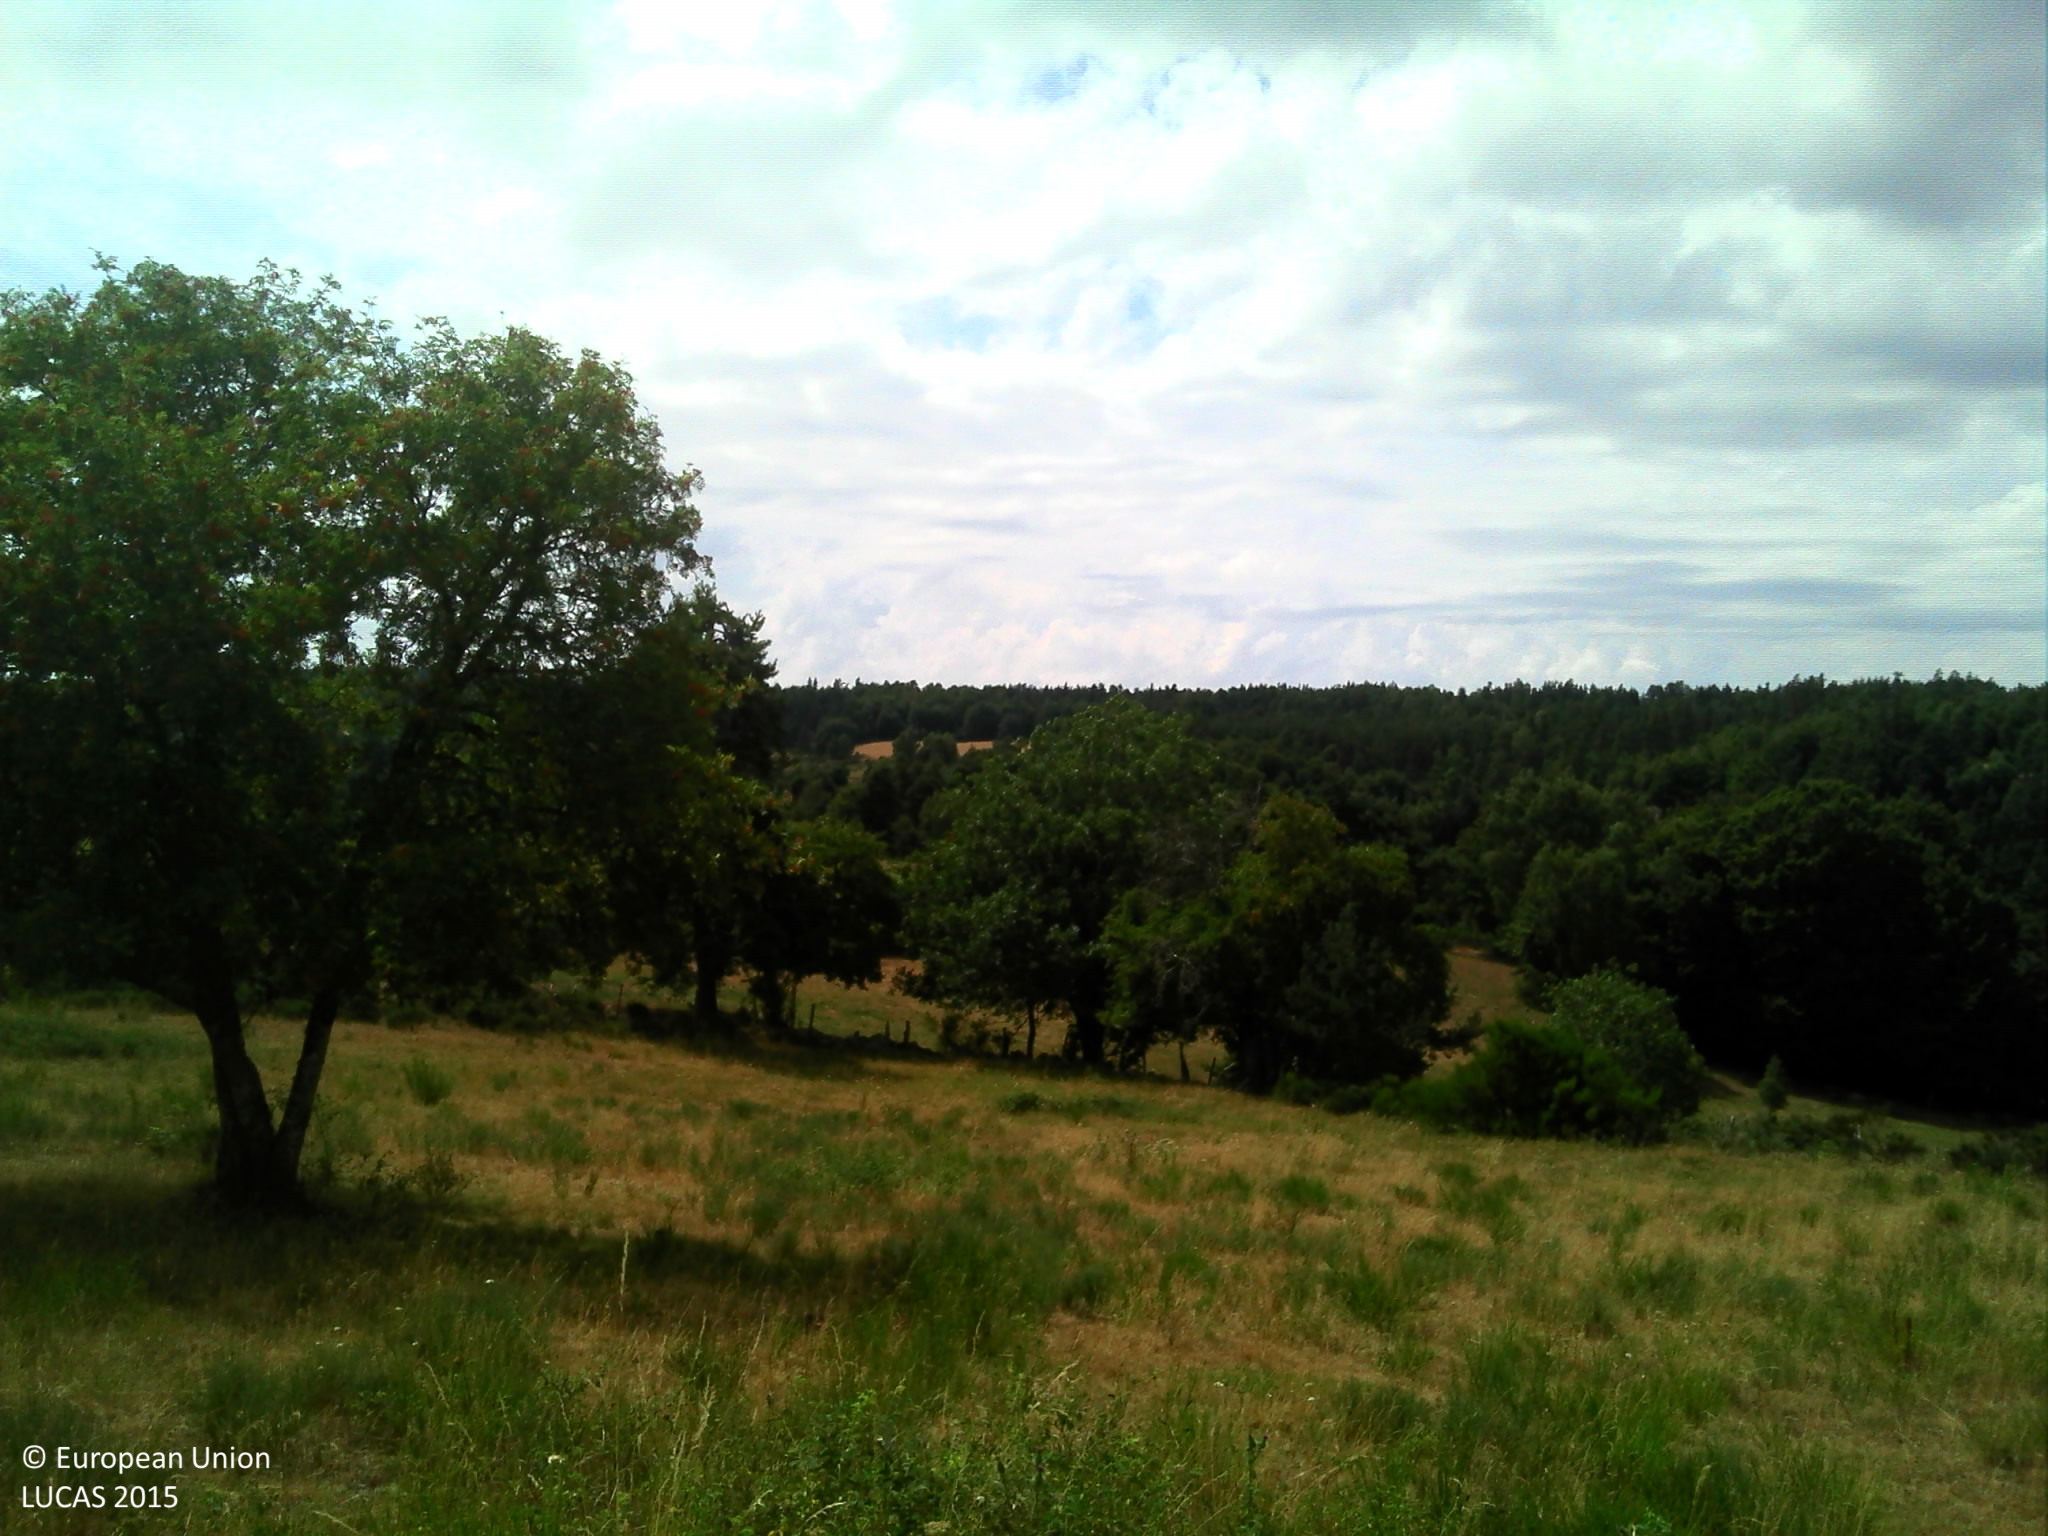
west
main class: Grassland
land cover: Grassland with sparse tree/shrub cover
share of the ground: > 75 %
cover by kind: herbaceous plants 85 %, shrubs 10 %, coniferous forest trees 5 %
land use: Agriculture (excluding fallow land and kitchen gardens)
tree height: < 5 m
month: July
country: FR
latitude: 44.6901
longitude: 3.2280
